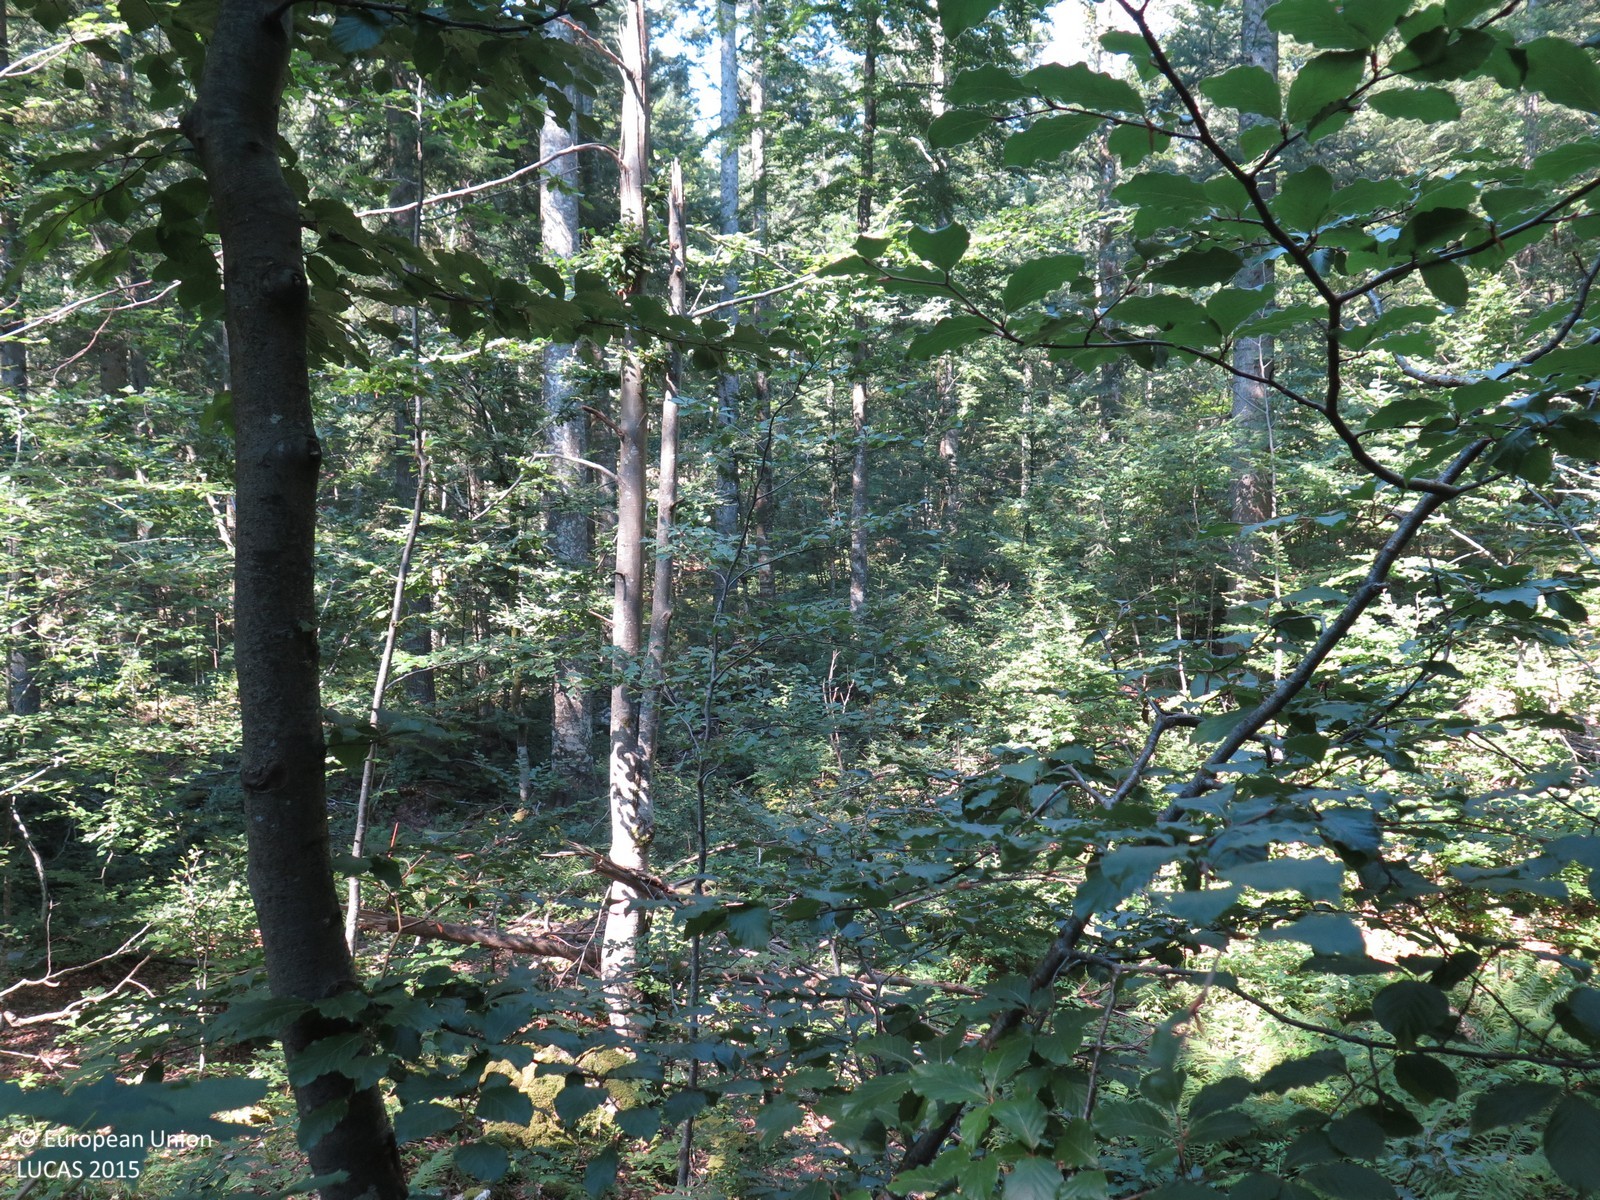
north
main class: Woodland
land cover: Other mixed woodland
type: mountainous beech forest
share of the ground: > 75 %
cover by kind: coniferous forest trees 75 %, broadleaved forest trees 25 %
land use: Forestry
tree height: > 5 m
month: August
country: HR
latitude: 45.5309
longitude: 14.5923
